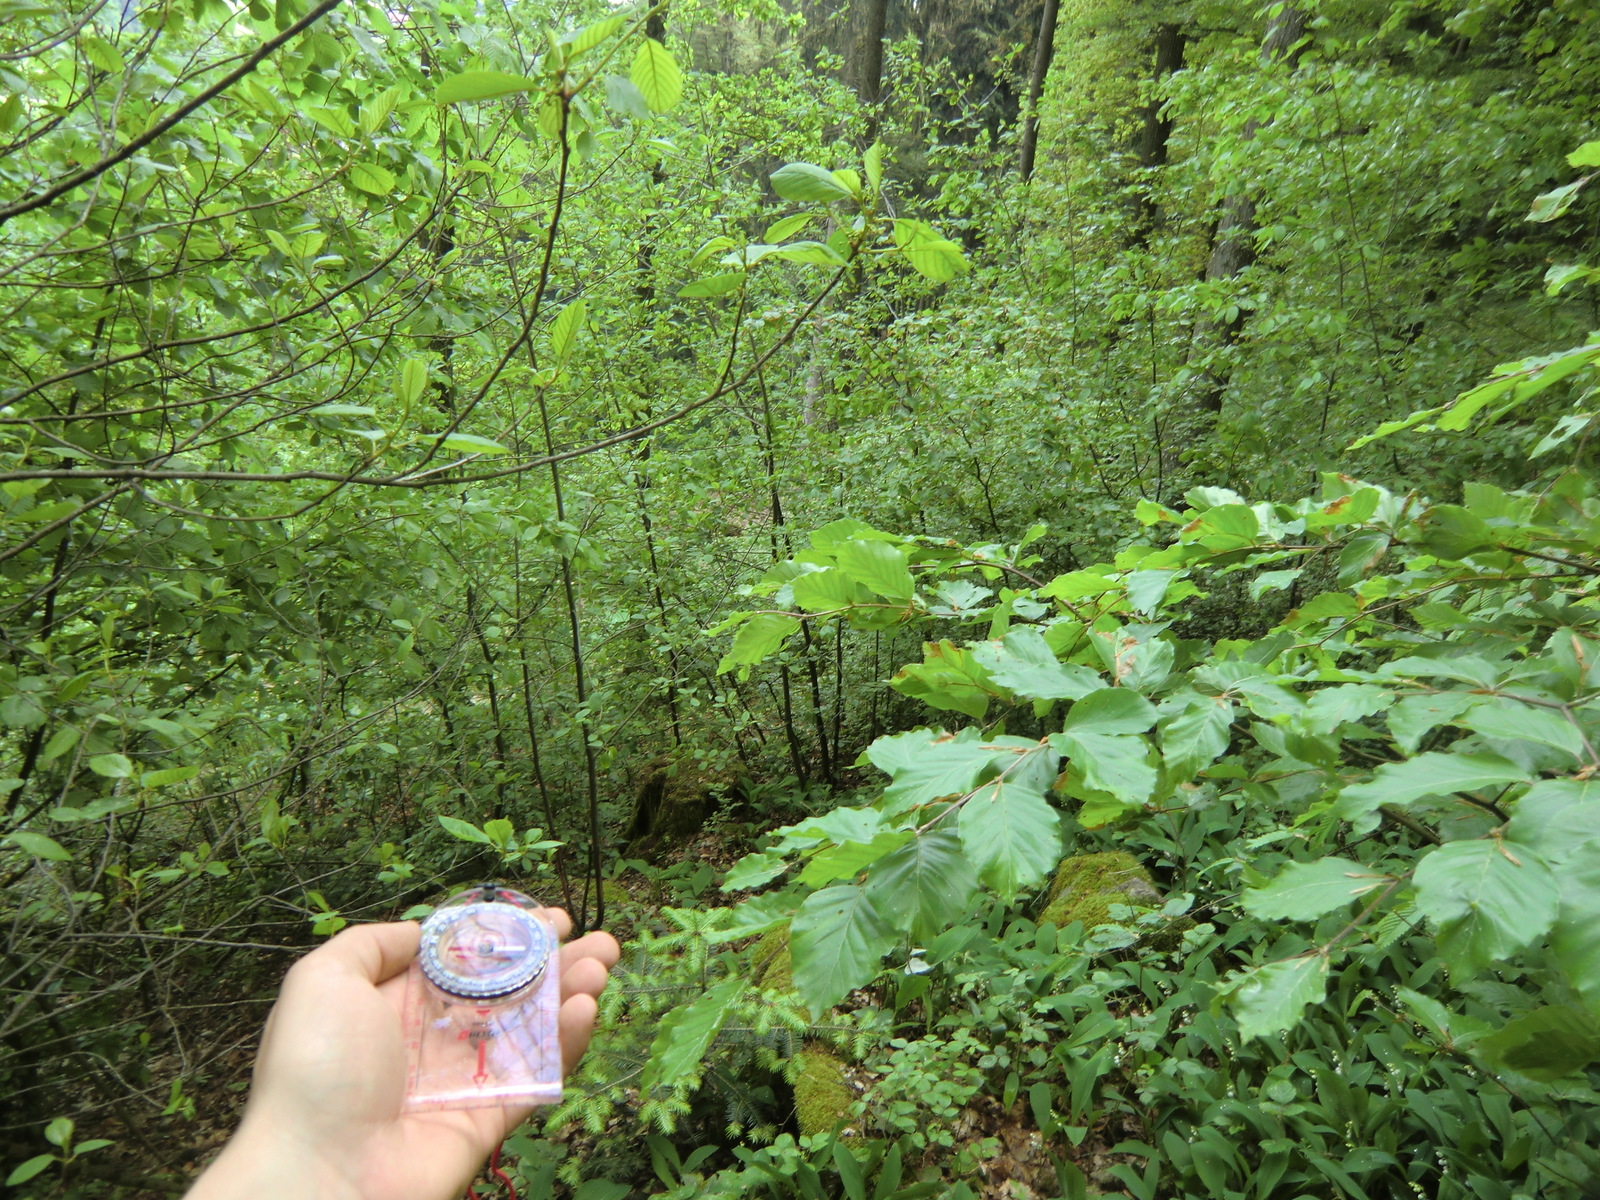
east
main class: Woodland
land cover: Spruce dominated mixed woodland
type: mountainous beech forest
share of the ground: > 75 %
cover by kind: broadleaved forest trees 30 %, shrubs 30 %, coniferous forest trees 20 %, herbaceous plants 10 %, unconsolidated bare surface 10 %
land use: Forestry
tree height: > 5 m
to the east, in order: Spruce dominated mixed woodland; Shrubland with sparse tree cover; Tracks; Shrubland with sparse tree cover; Other bare soil; Spruce dominated mixed woodland; Shrubland with sparse tree cover; Tracks; Grass margins; Barley
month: May
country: AT
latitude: 48.2709
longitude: 14.6219
